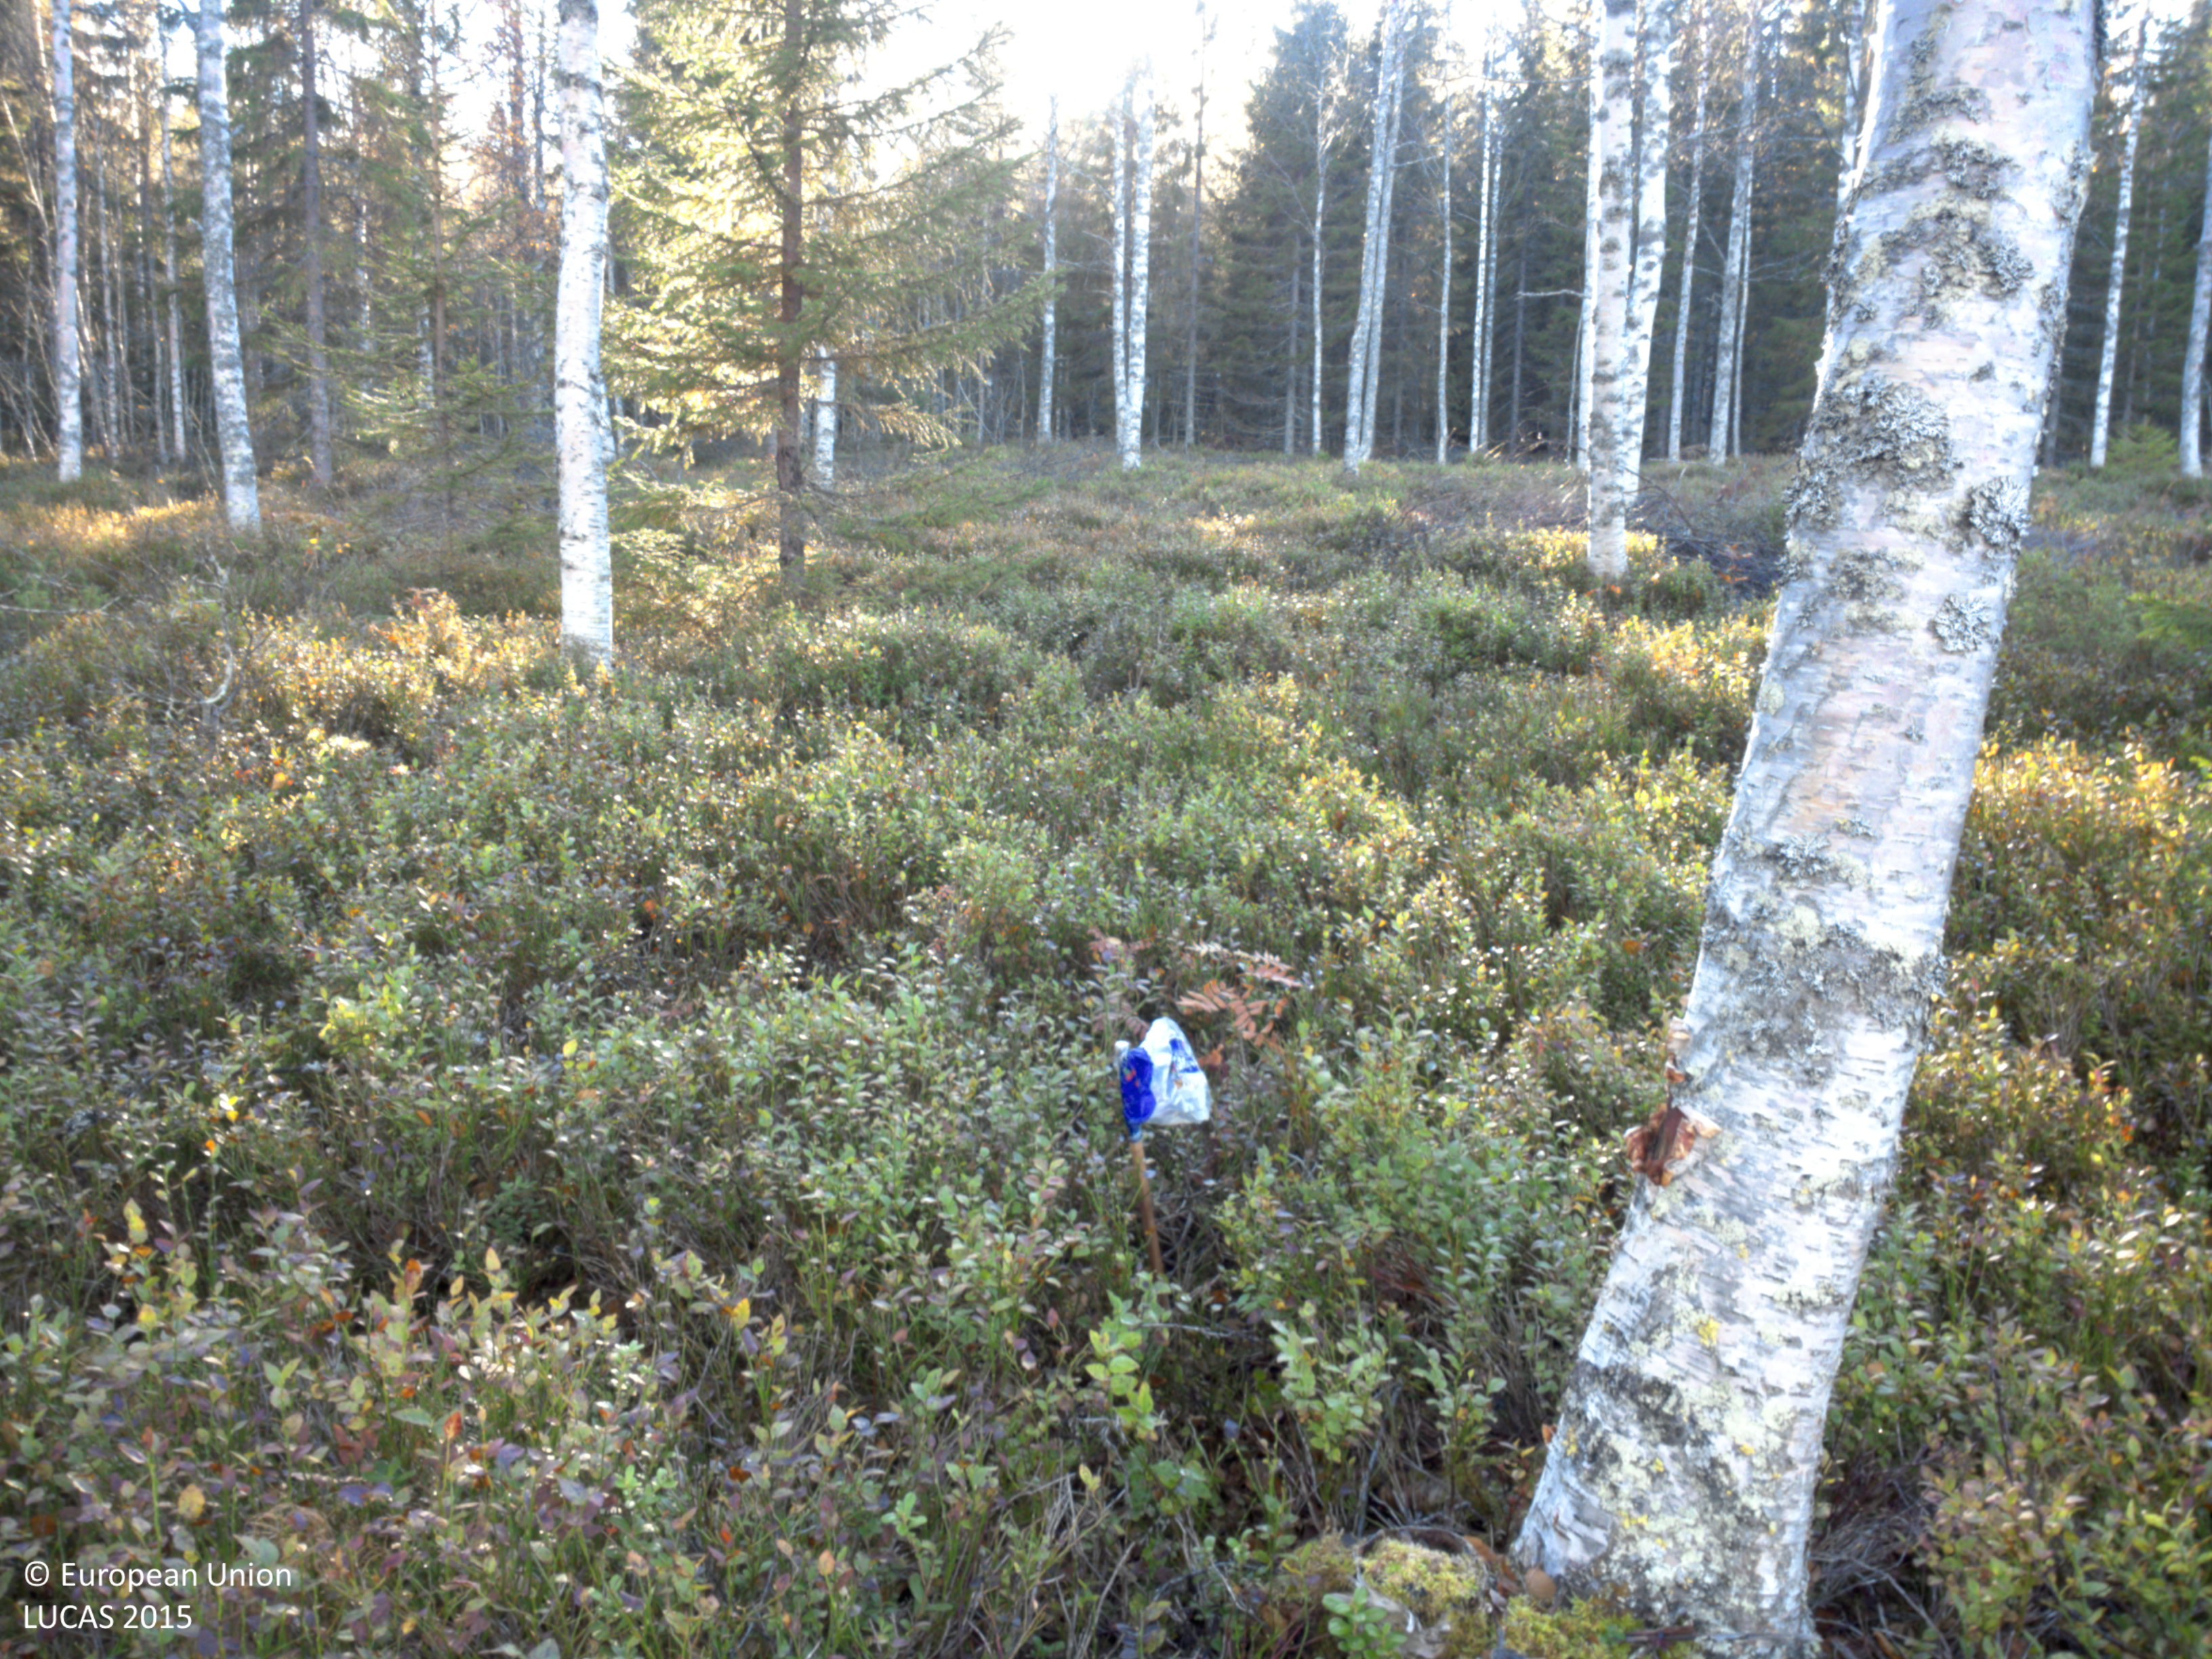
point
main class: Woodland
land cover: Spruce dominated mixed woodland
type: boreal forest
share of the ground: 50 - 75 %
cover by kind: coniferous forest trees 50 %, broadleaved forest trees 25 %, shrubs 15 %, herbaceous plants 5 %, lichens and mosses 5 %
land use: Forestry
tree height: > 5 m
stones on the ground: < 10 %
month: October
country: SE
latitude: 64.0781
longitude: 18.8505
